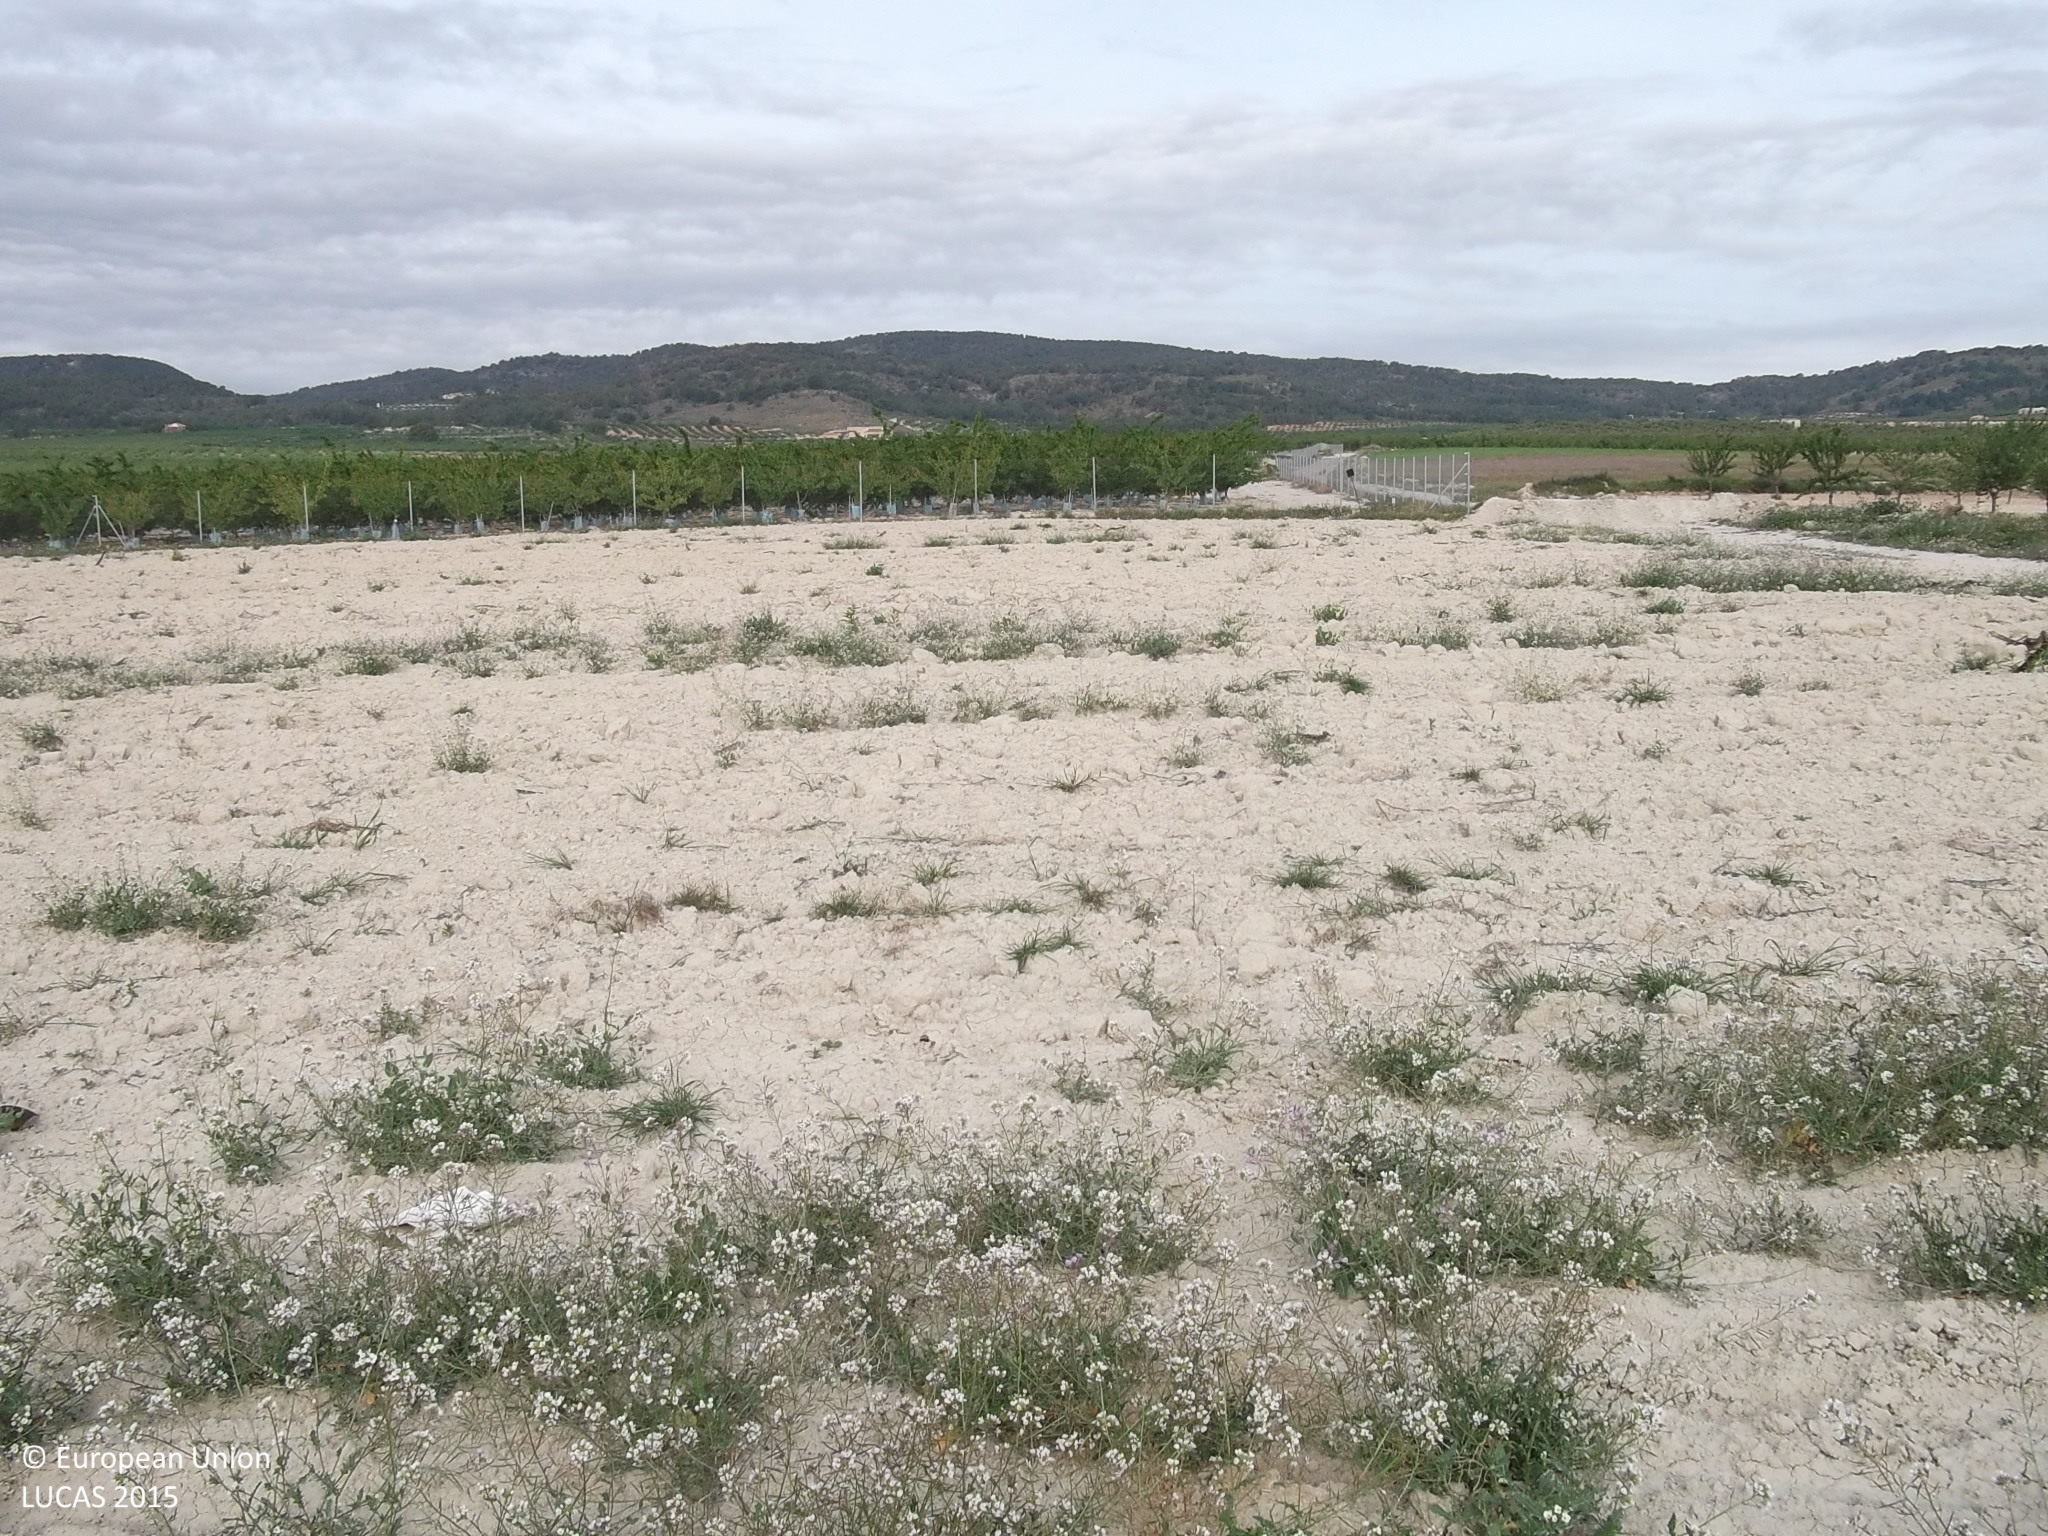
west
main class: Grassland
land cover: Spontaneously vegetated surfaces
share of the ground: 10 - 25 %
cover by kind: consolidated bare surface 80 %, herbaceous plants 20 %
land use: Fallow land
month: April
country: ES
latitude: 37.9865
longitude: -1.4510
